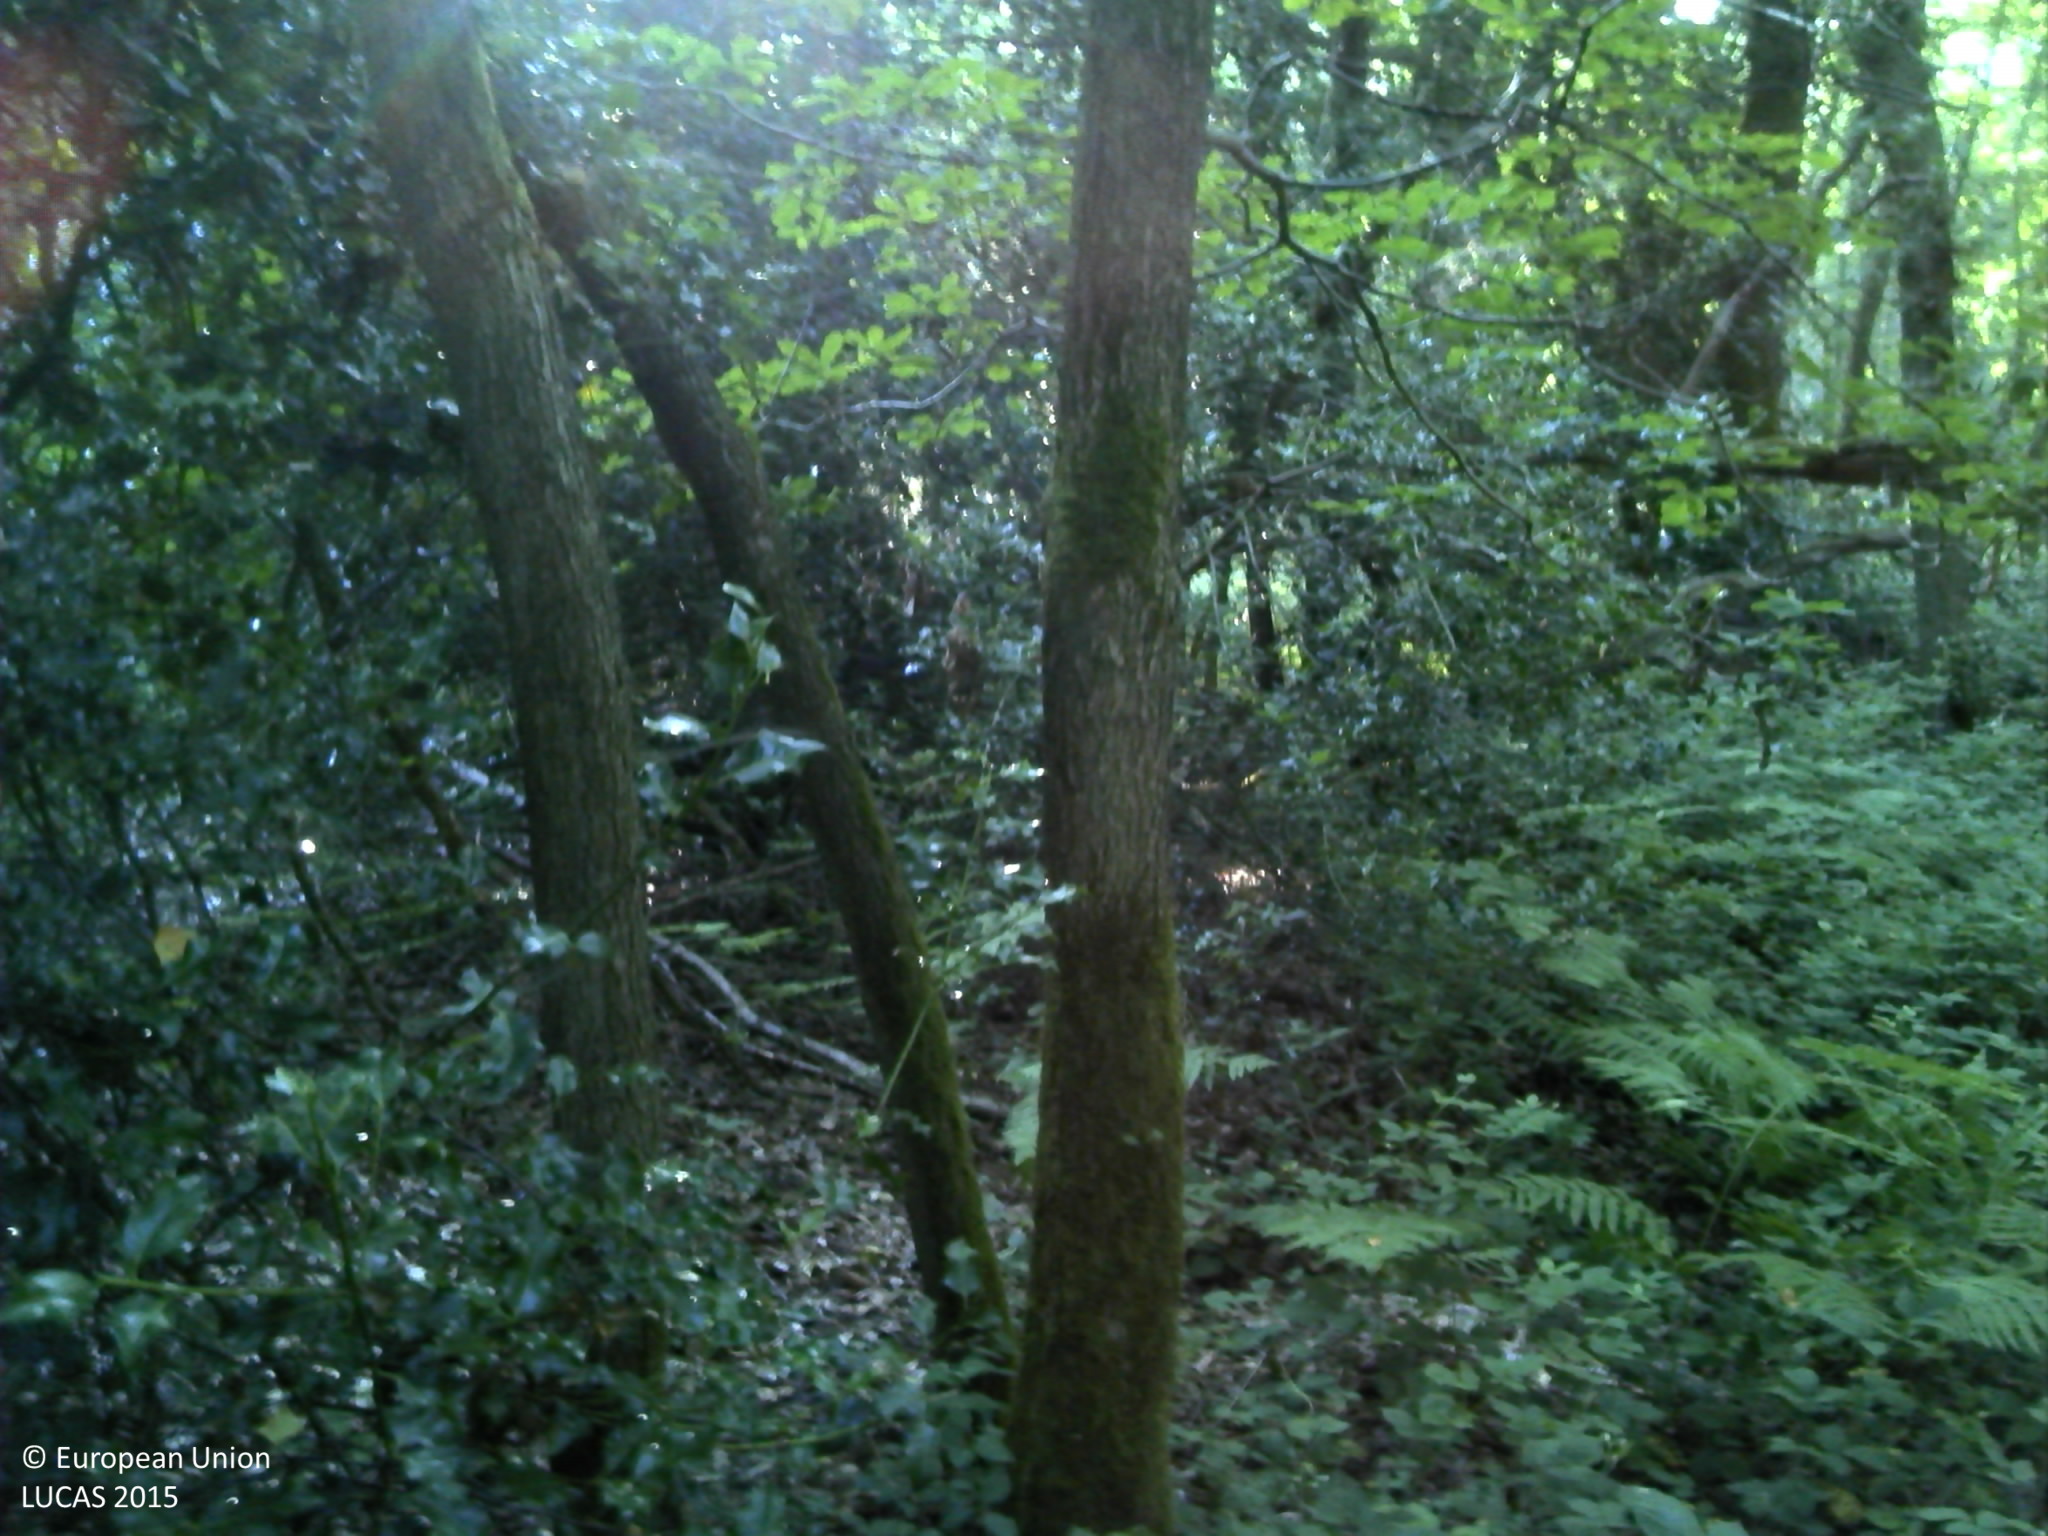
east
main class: Woodland
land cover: Broadleaved woodland
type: acidophilous oak and oak-birch forest
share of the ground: > 75 %
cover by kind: broadleaved forest trees 100 %
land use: Forestry
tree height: > 5 m
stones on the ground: 25 - 50 %
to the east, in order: Broadleaved woodland; Spruce dominated coniferous woodland; Broadleaved woodland; Tracks; Broadleaved woodland; Grassland without tree/shrub cover; Fences; Grassland without tree/shrub cover
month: July
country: FR
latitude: 49.3579
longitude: 1.2370
